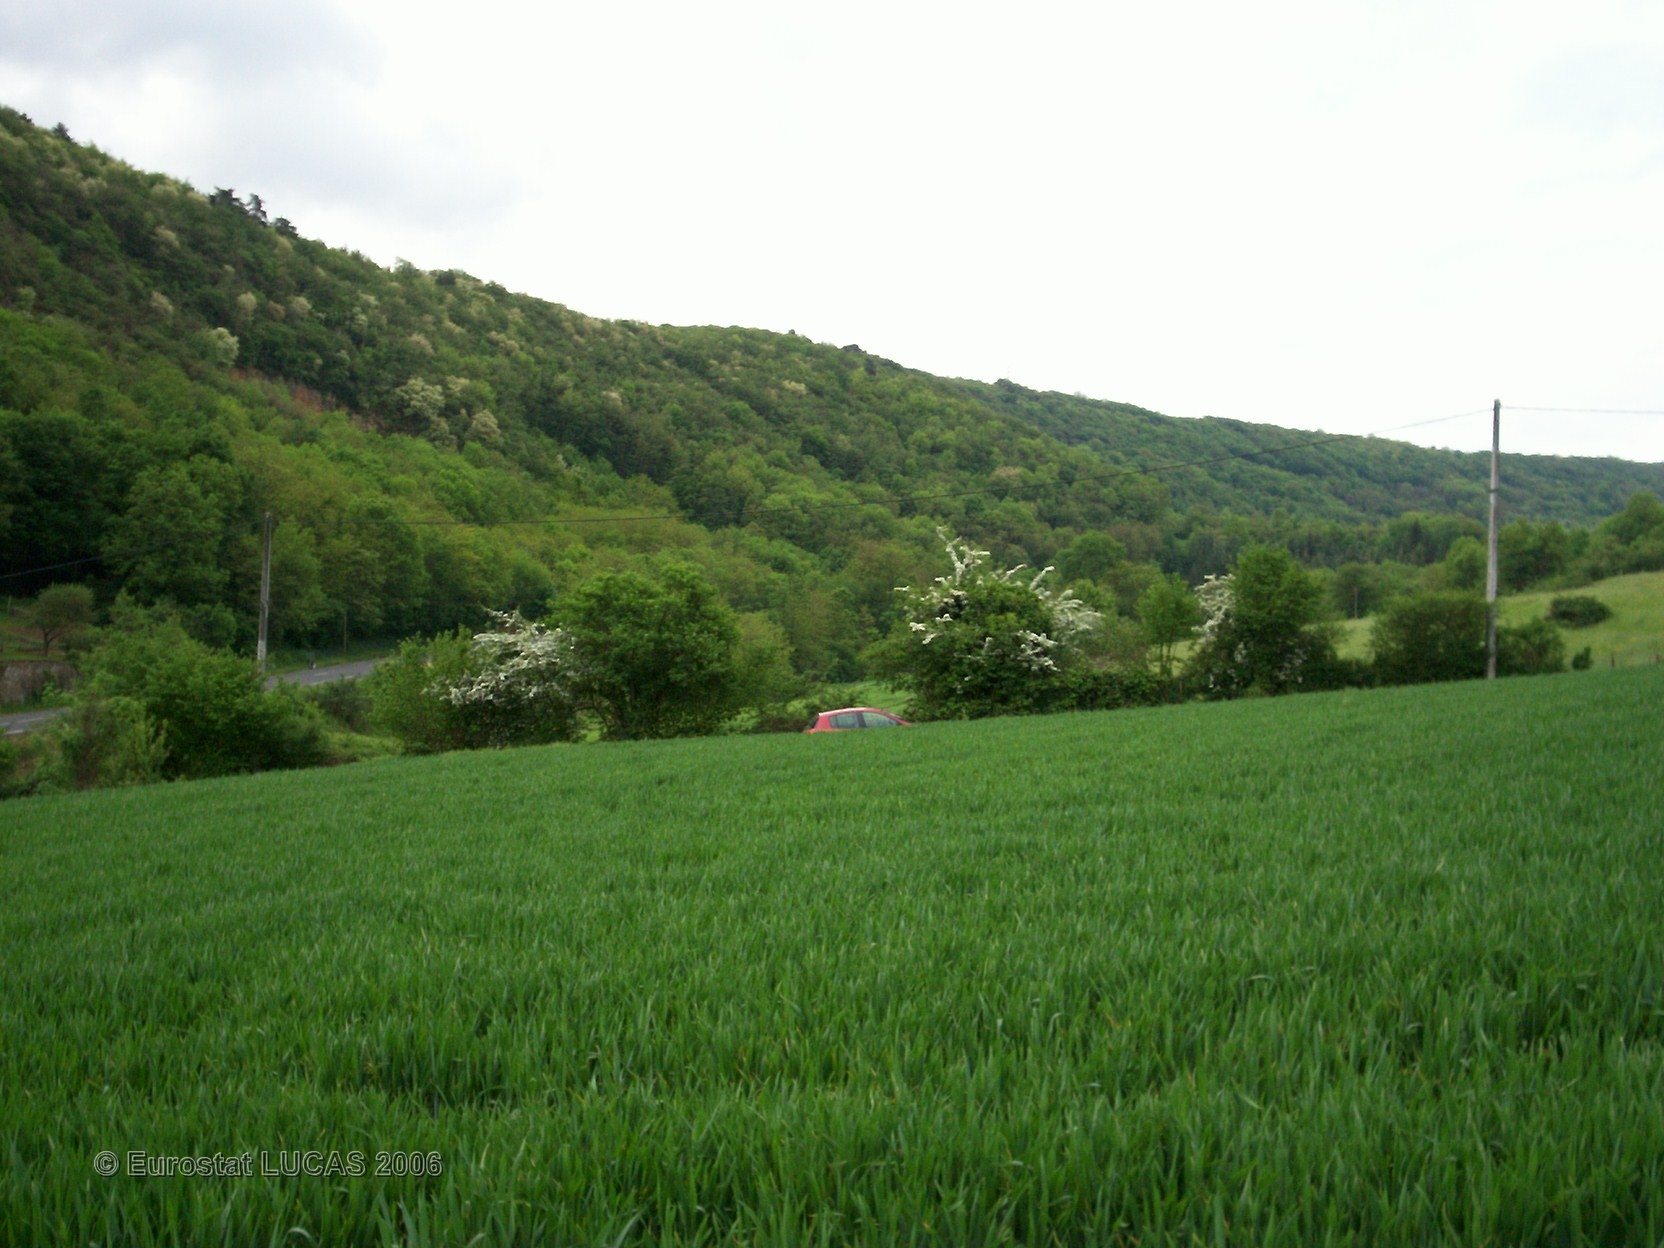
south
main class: Cropland
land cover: Common wheat
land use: Agriculture (excluding fallow land and kitchen gardens)
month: May
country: FR
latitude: 45.8644
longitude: 4.8122
